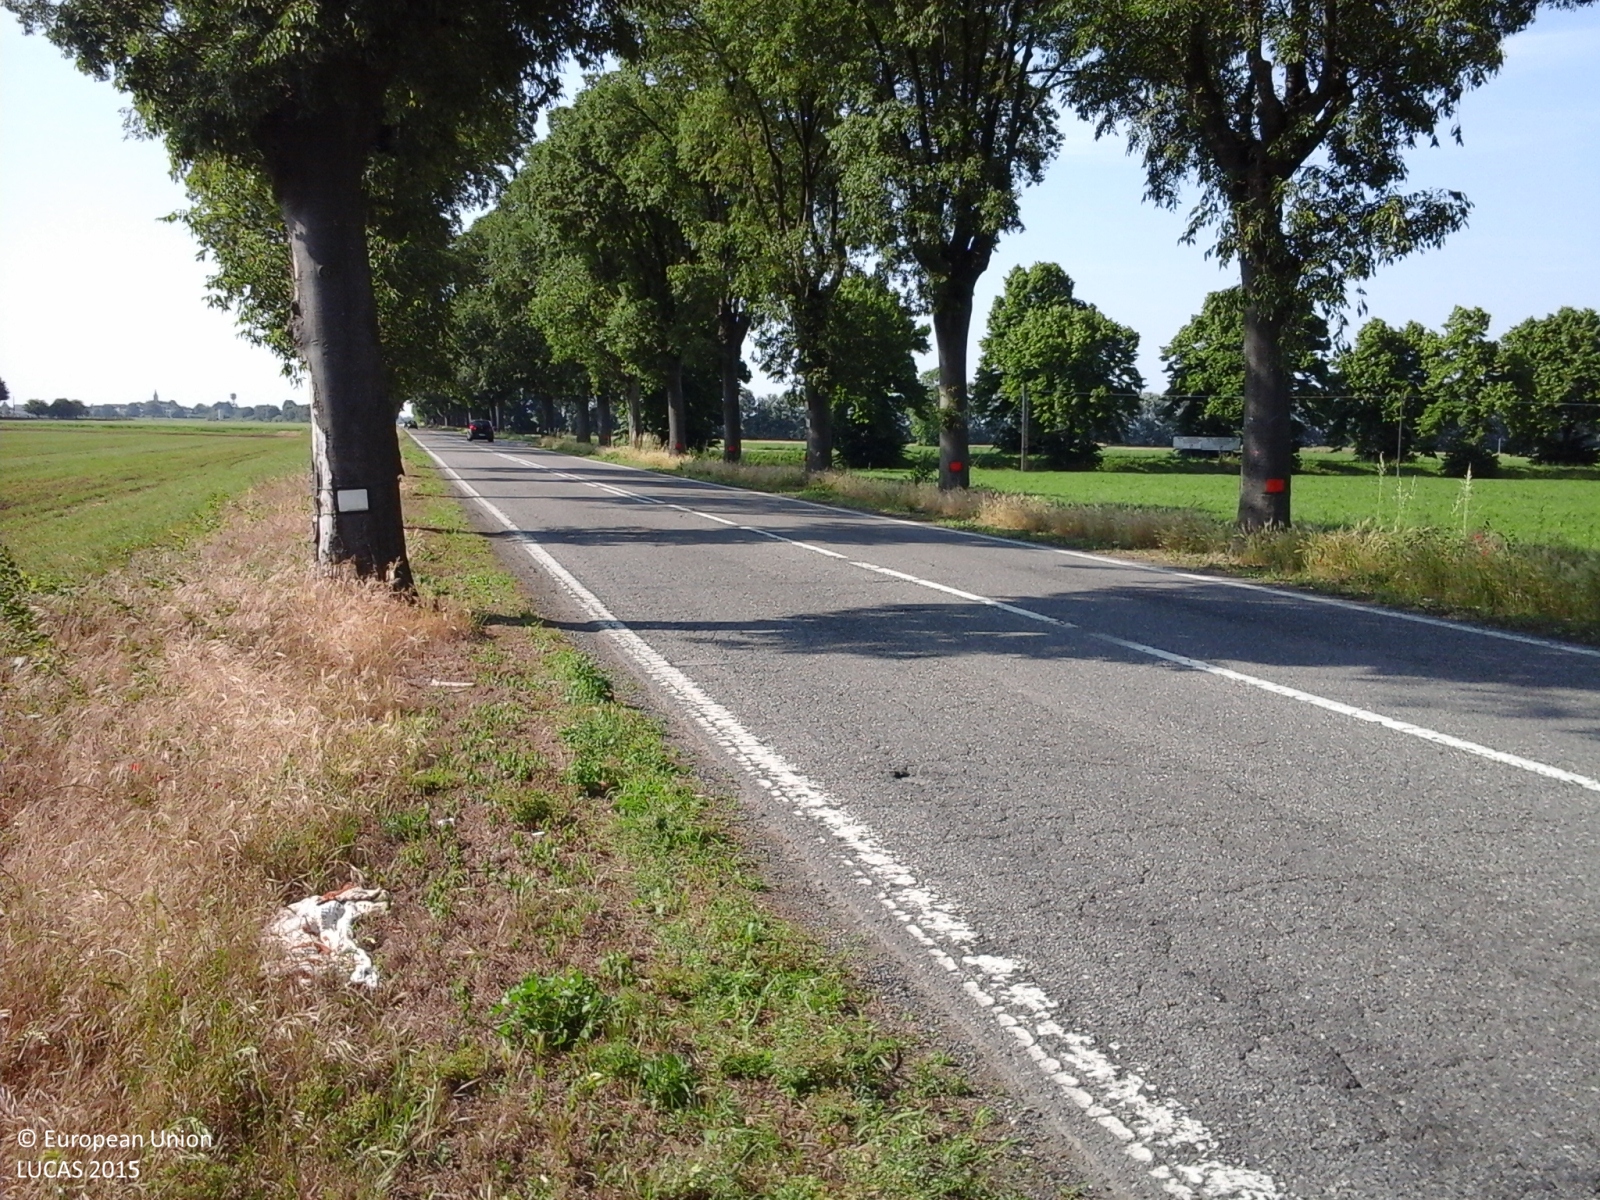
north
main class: Cropland
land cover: Temporary grasslands
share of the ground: > 75 %
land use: Agriculture (excluding fallow land and kitchen gardens)
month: May
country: IT
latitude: 45.2153
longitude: 9.6060
